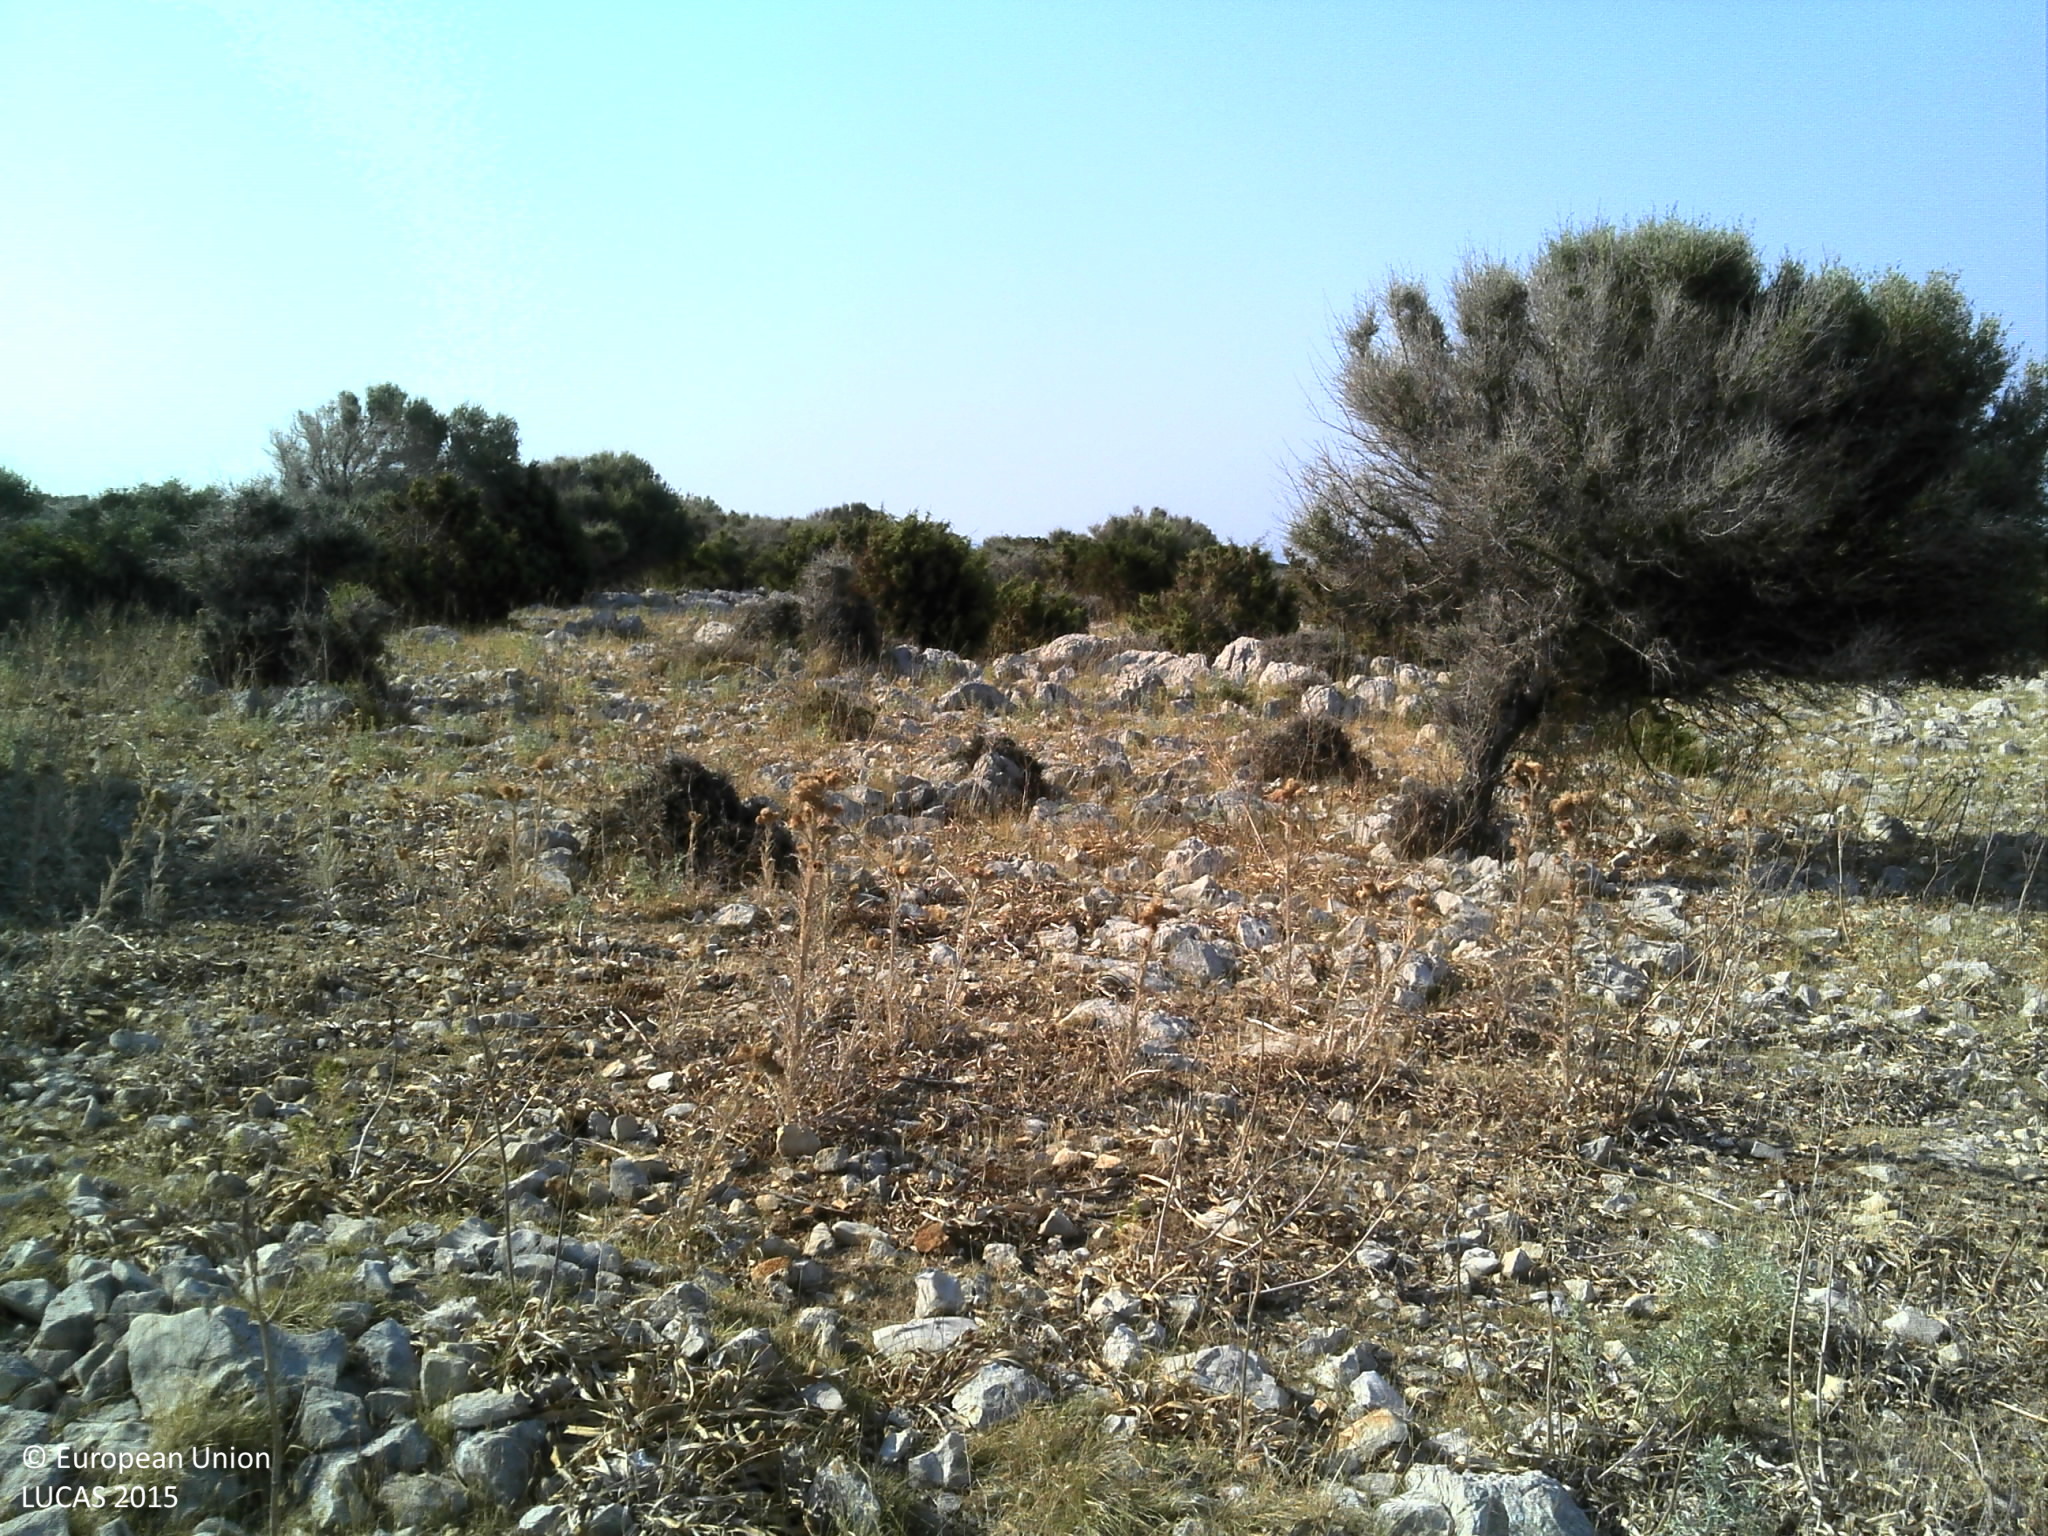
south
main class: Grassland
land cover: Grassland with sparse tree/shrub cover
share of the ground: 25 - 50 %
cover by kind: unconsolidated bare surface 40 %, herbaceous plants 35 %, consolidated bare surface 15 %, broadleaved forest trees 5 %, shrubs 5 %
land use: Agriculture (excluding fallow land and kitchen gardens)
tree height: < 5 m
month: July
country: HR
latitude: 44.6371
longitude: 14.7964
